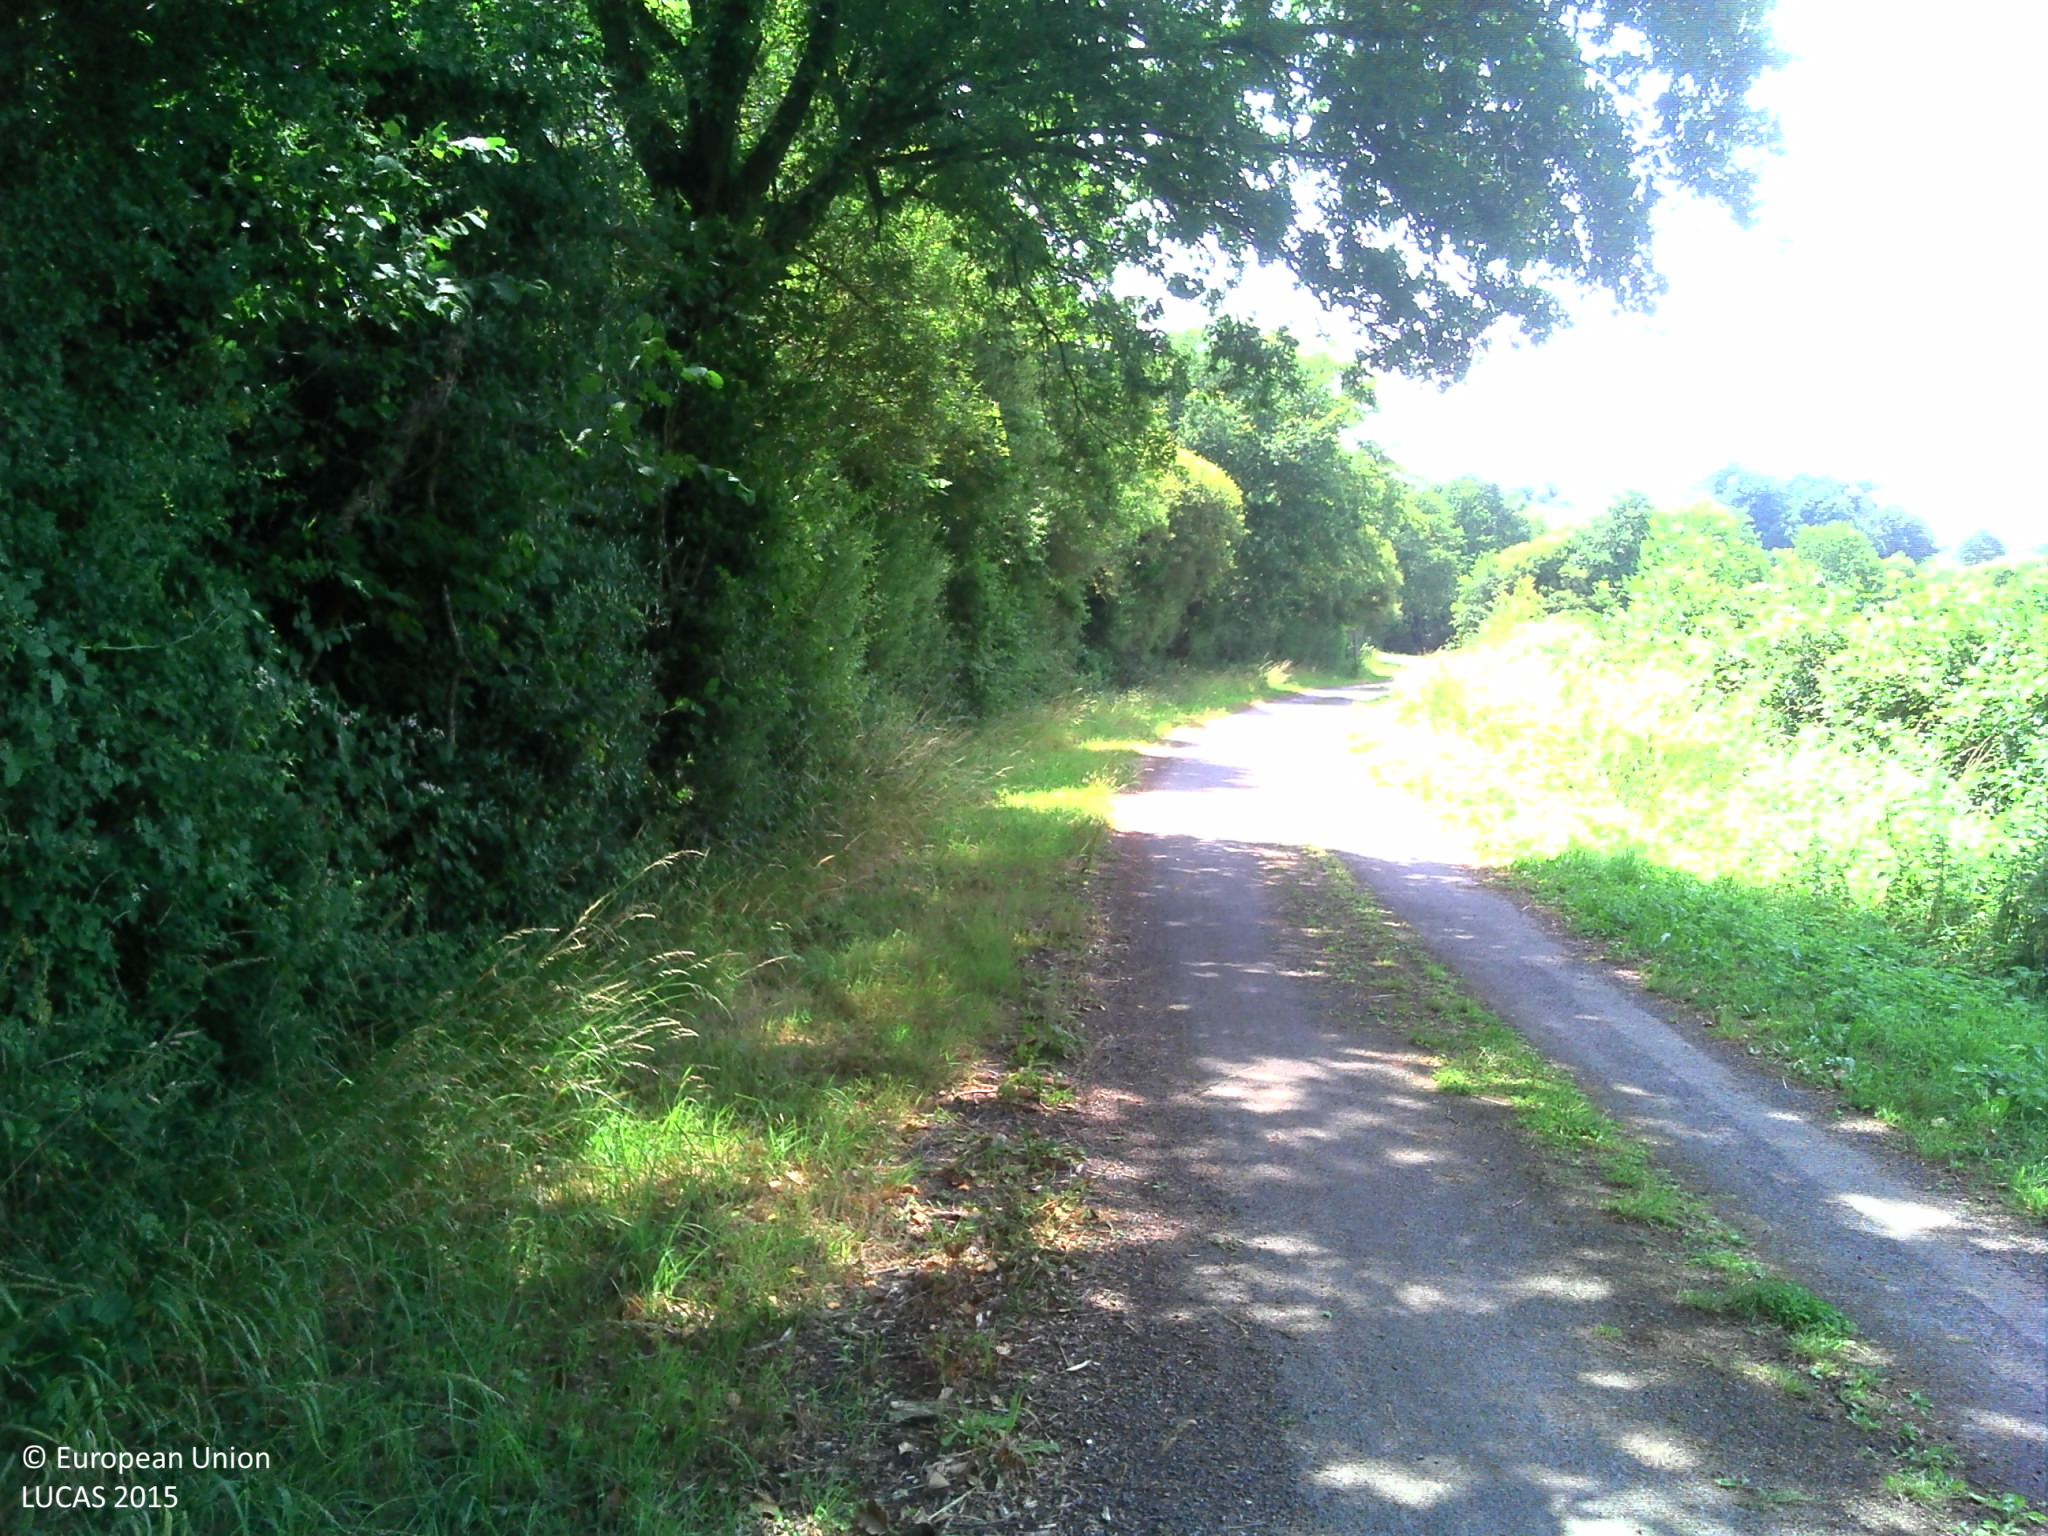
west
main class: Artificial land
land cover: Non built-up linear features
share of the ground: > 75 %
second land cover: Grassland without tree/shrub cover
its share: 10 - 25 %
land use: Road transport
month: July
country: FR
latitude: 46.9524
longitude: -0.9259
